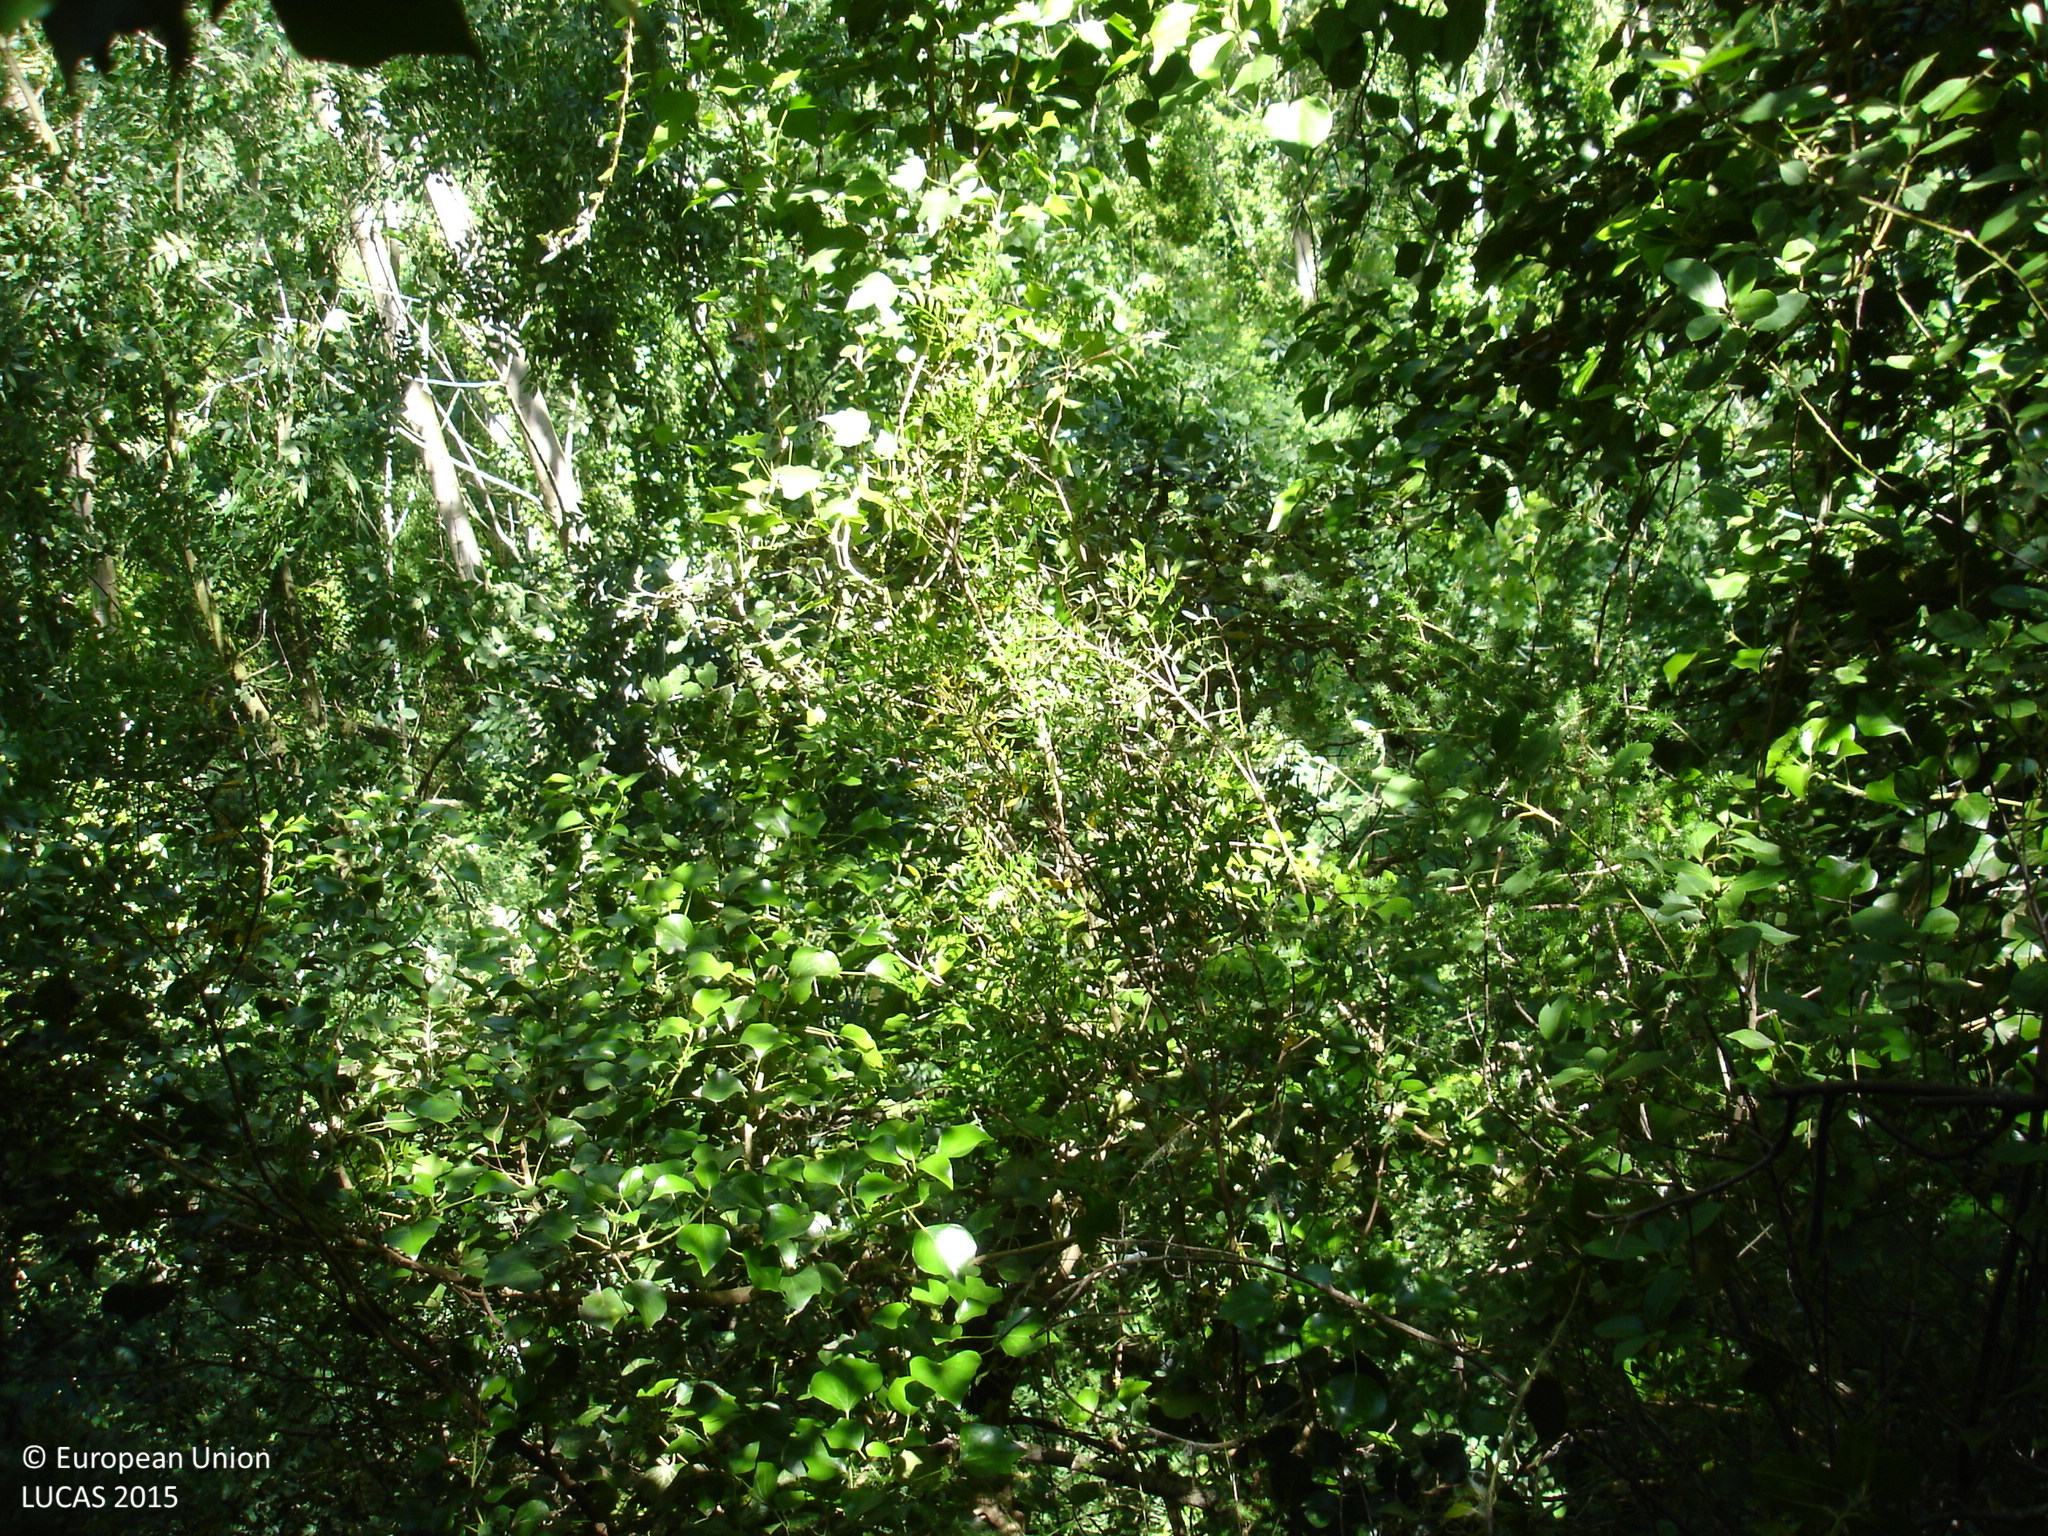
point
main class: Woodland
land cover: Broadleaved woodland
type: thermophilous deciduous forest
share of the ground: > 75 %
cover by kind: broadleaved forest trees 90 %, shrubs 10 %
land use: Forestry
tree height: > 5 m
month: May
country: ES
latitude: 42.1568
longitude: 2.9832
